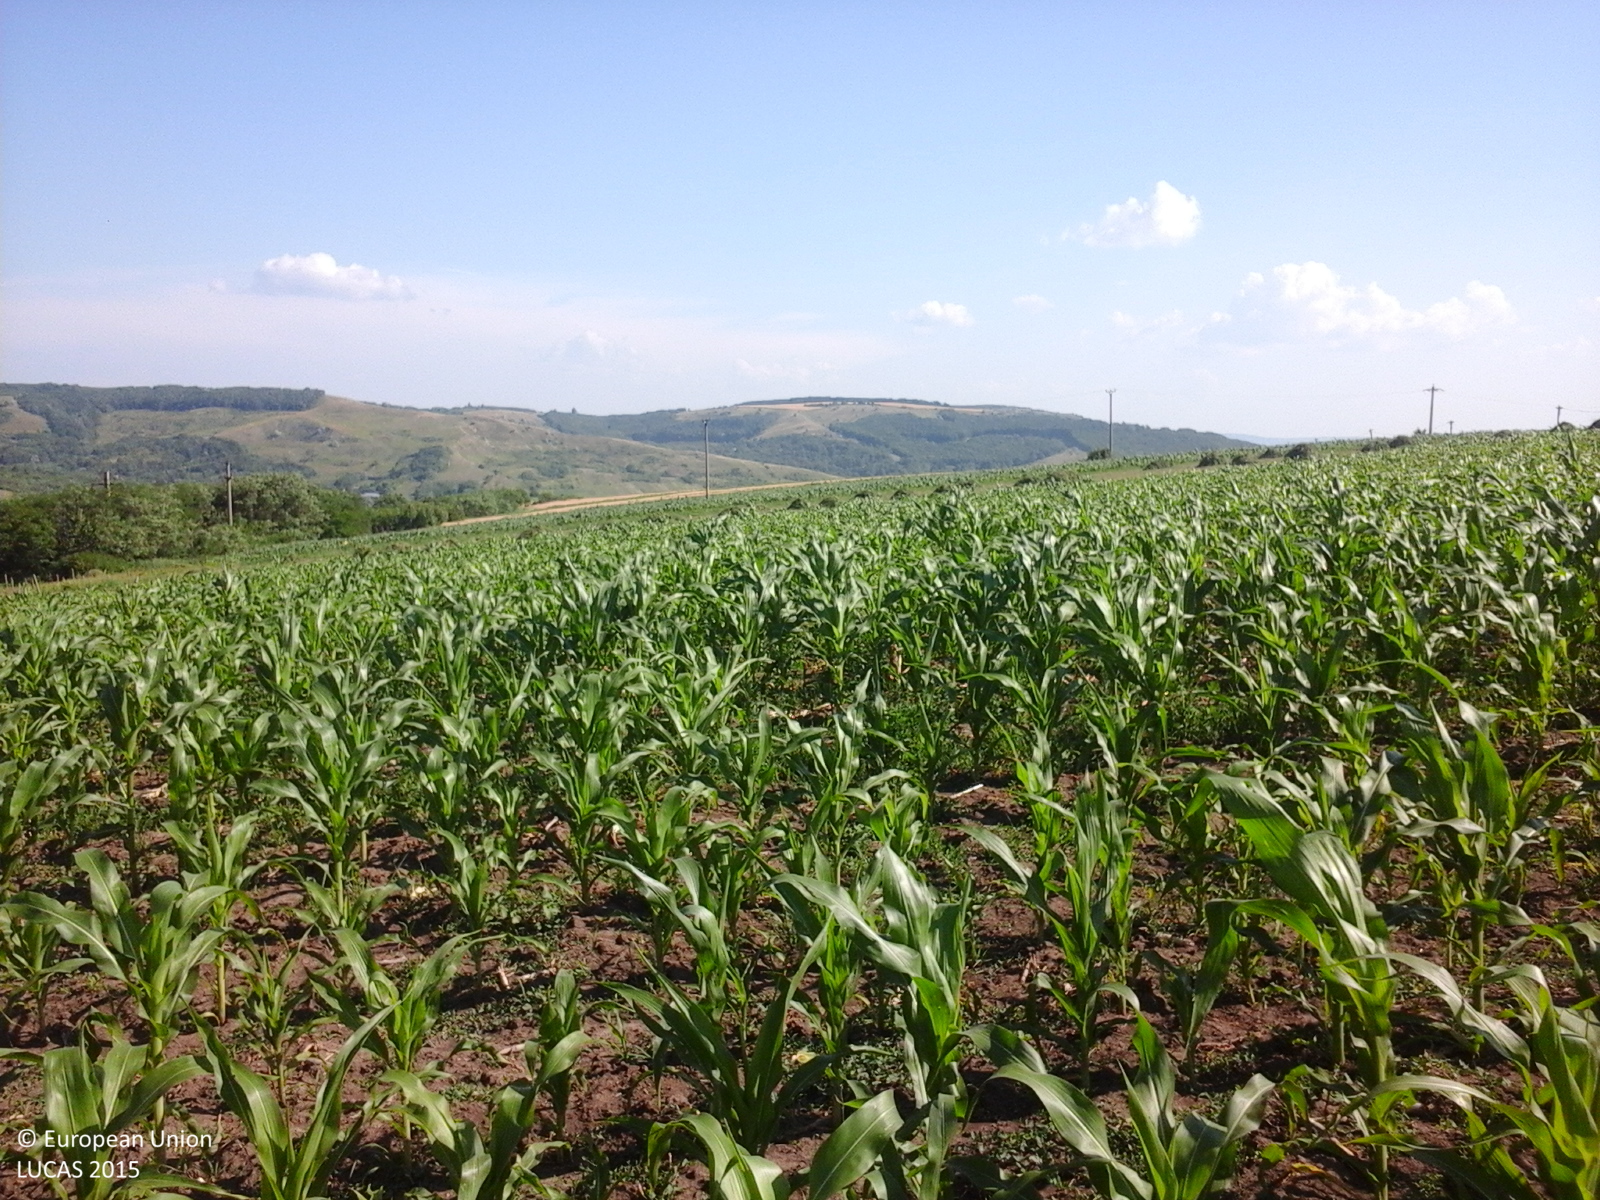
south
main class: Cropland
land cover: Maize
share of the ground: 25 - 50 %
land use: Agriculture (excluding fallow land and kitchen gardens)
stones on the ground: < 10 %
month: June
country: RO
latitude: 46.7837
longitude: 27.9813
